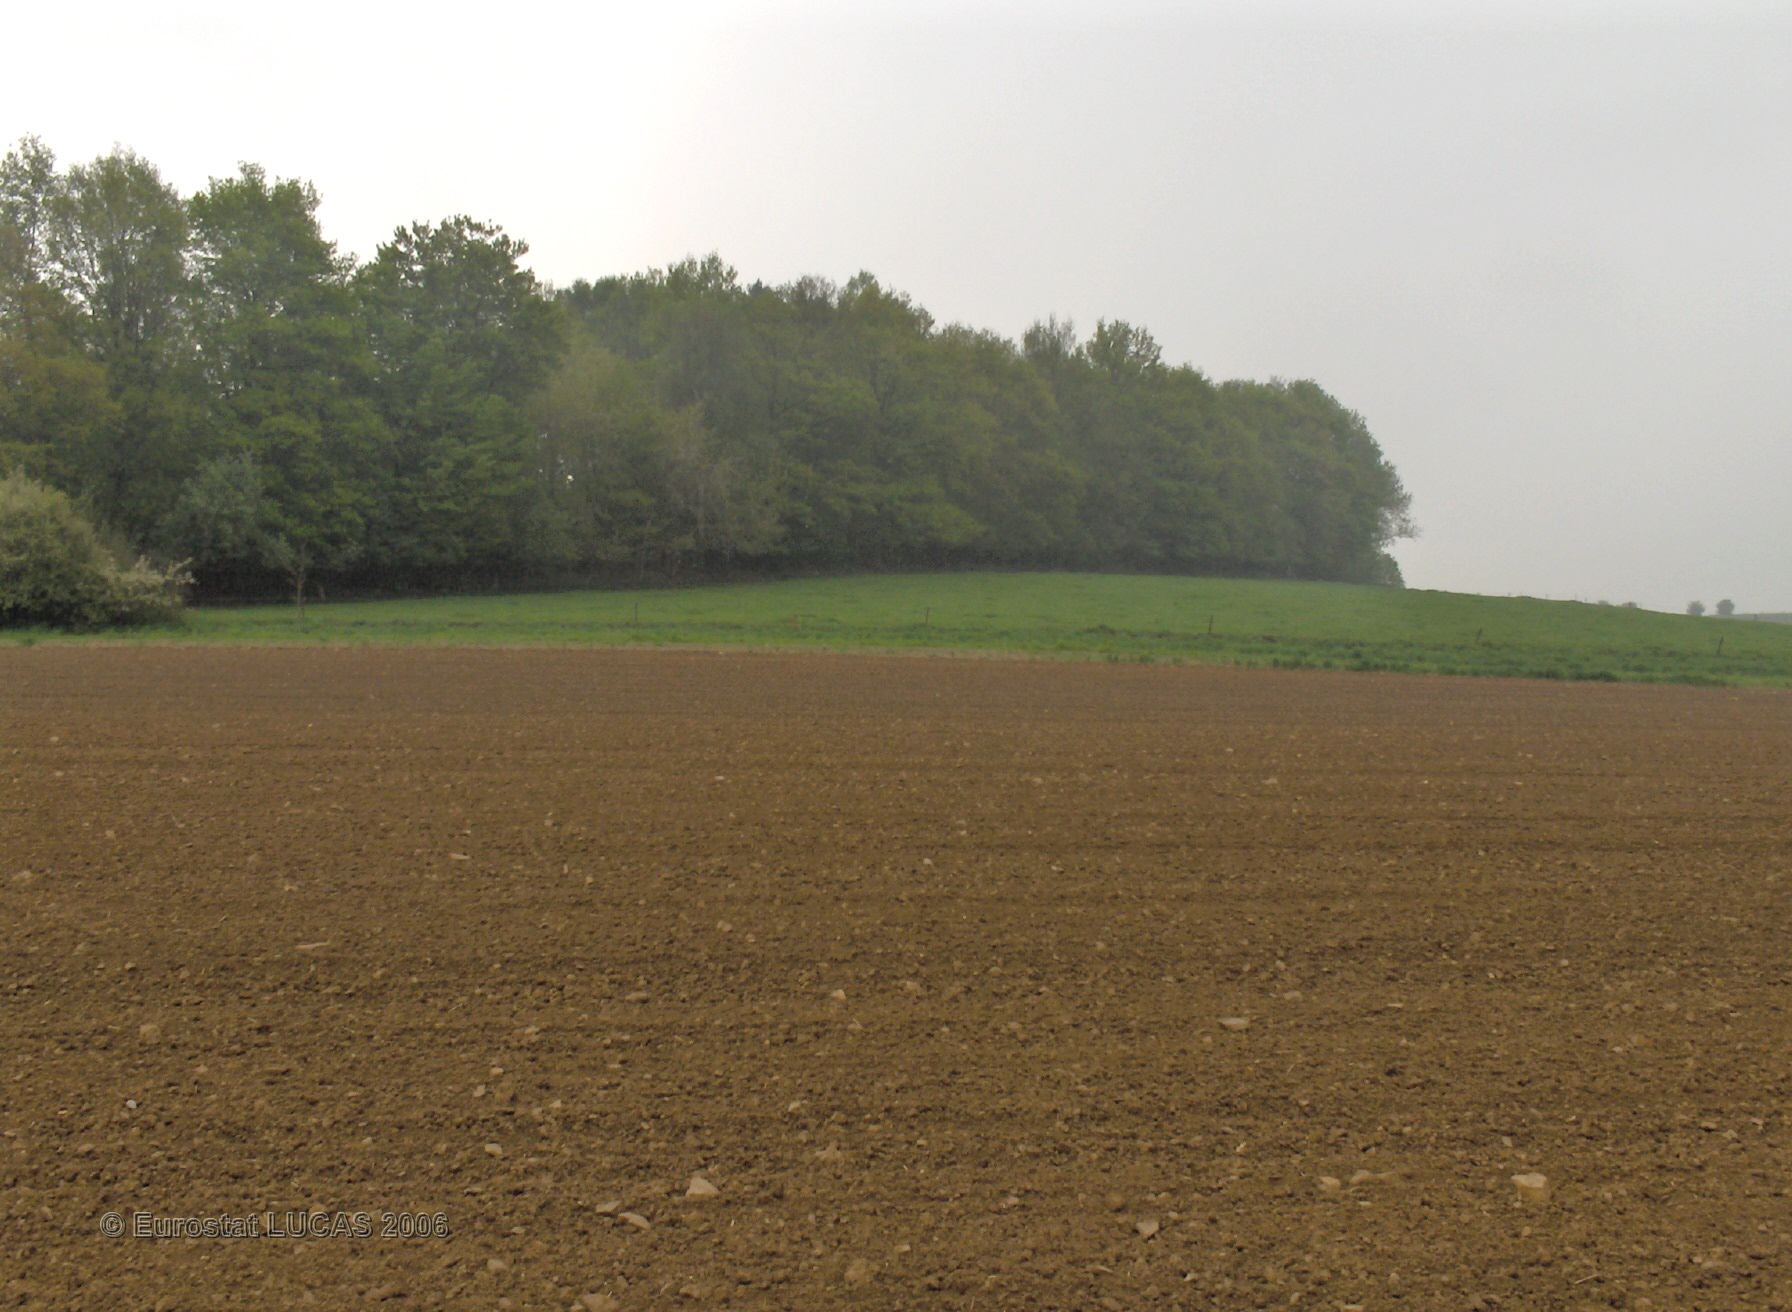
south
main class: Cropland
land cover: Maize
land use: Agriculture (excluding fallow land and kitchen gardens)
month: May
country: BE
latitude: 50.4445
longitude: 5.2239
